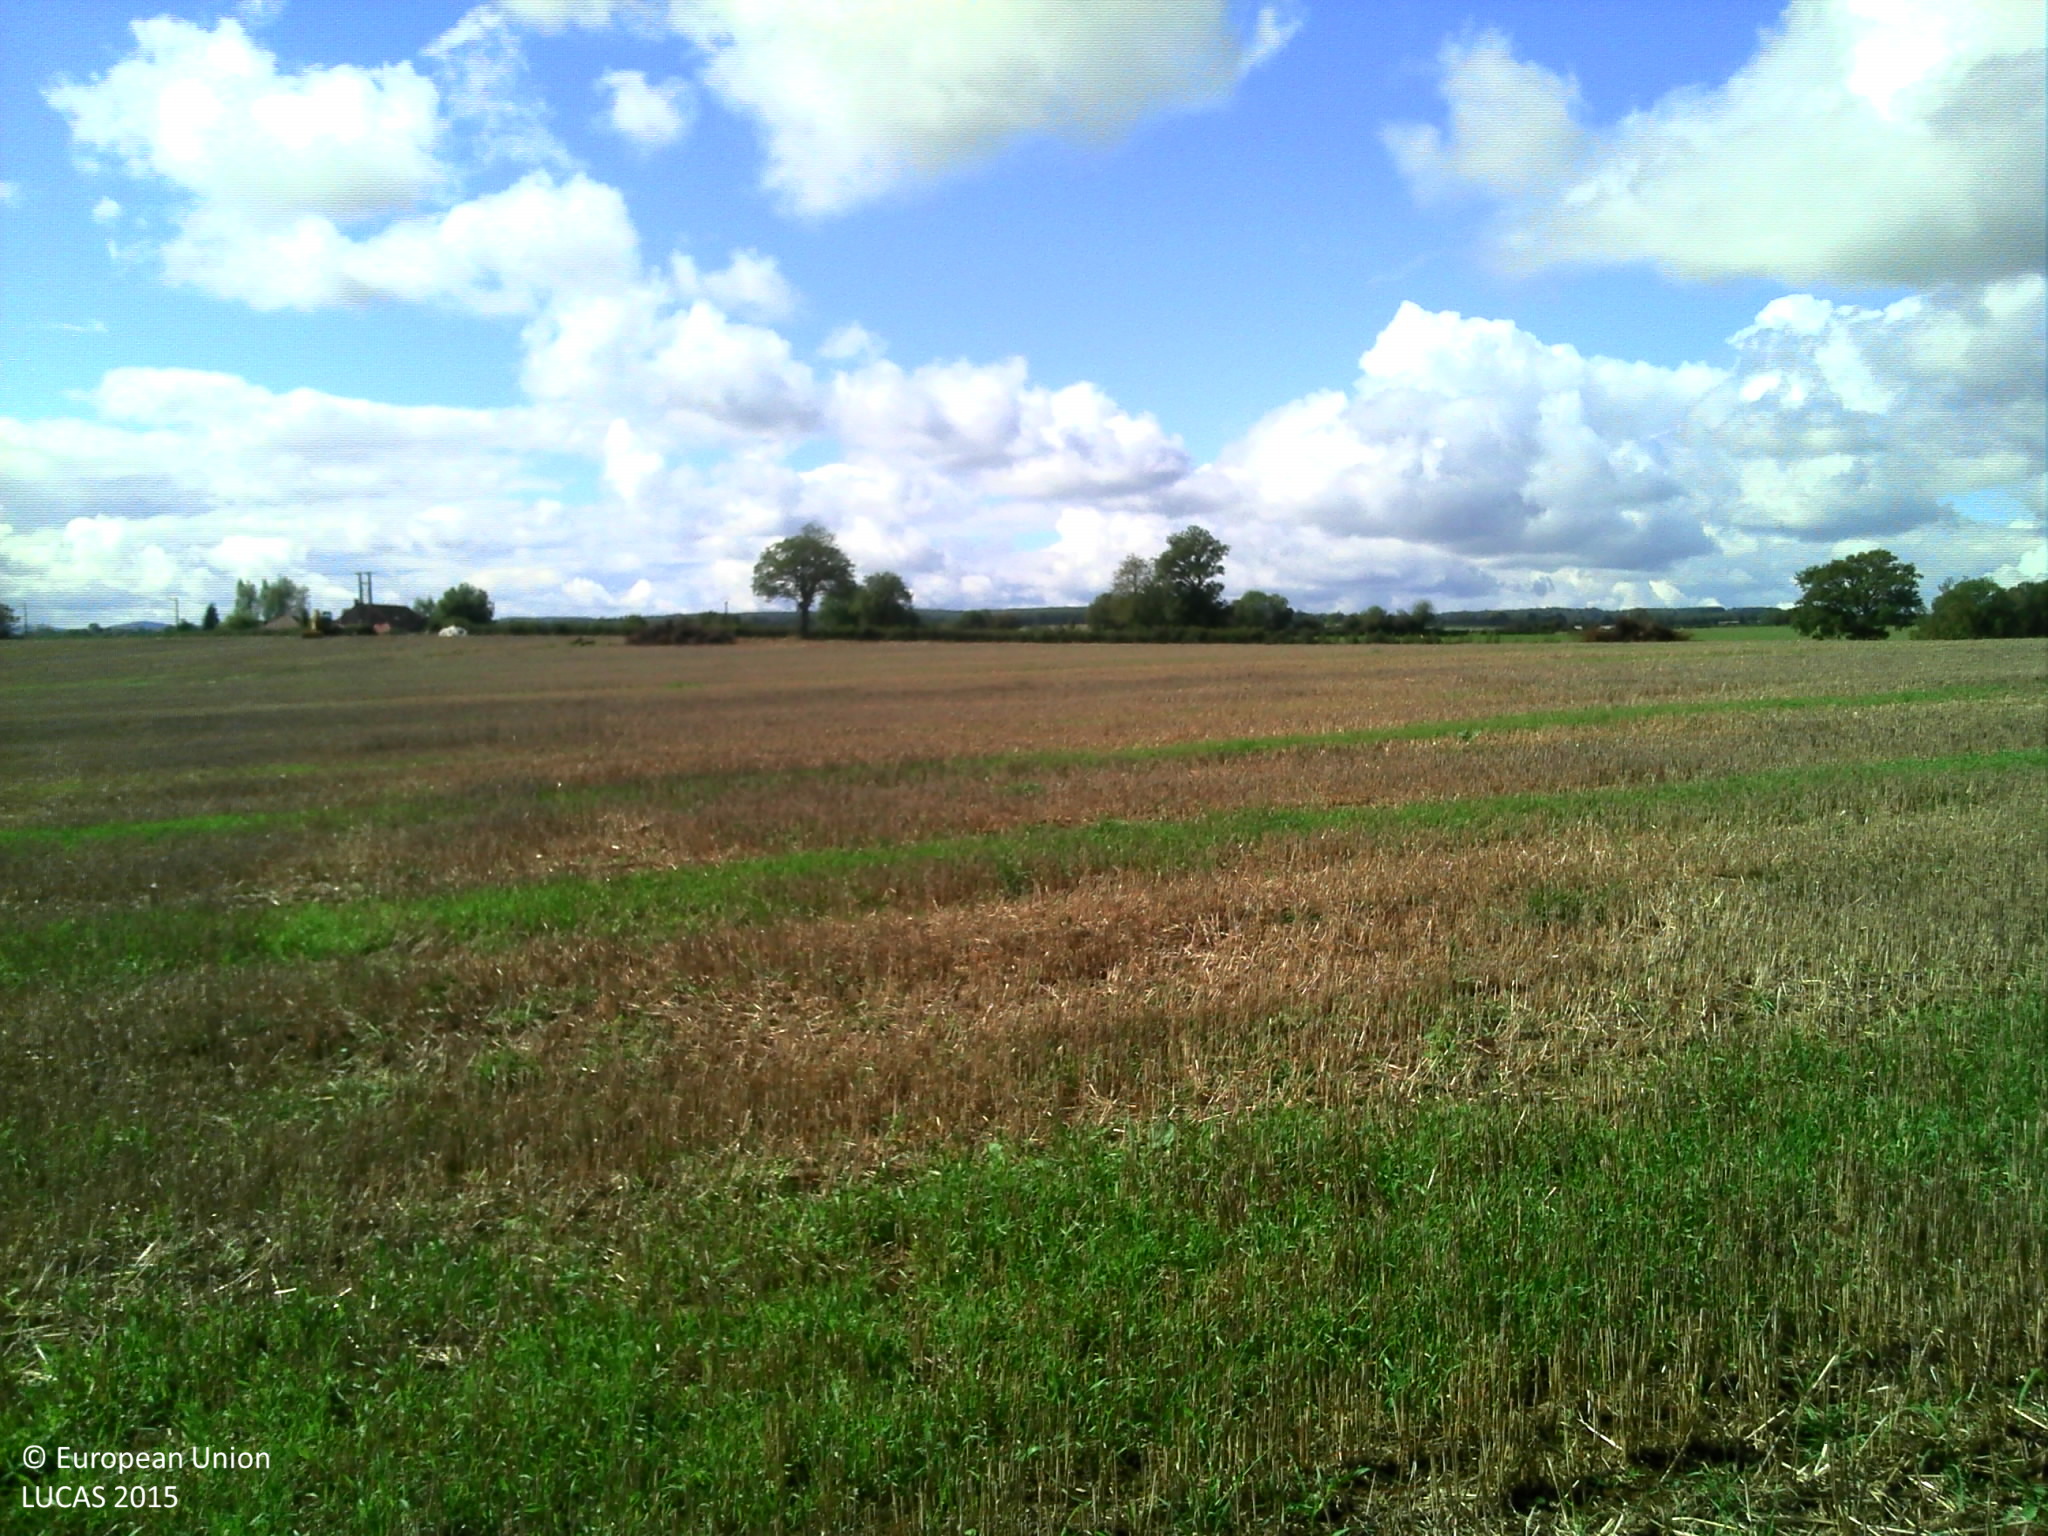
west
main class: Grassland
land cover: Grassland without tree/shrub cover
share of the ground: > 75 %
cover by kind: herbaceous plants 100 %
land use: Railway transport
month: September
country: FR
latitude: 47.2105
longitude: 4.3088
